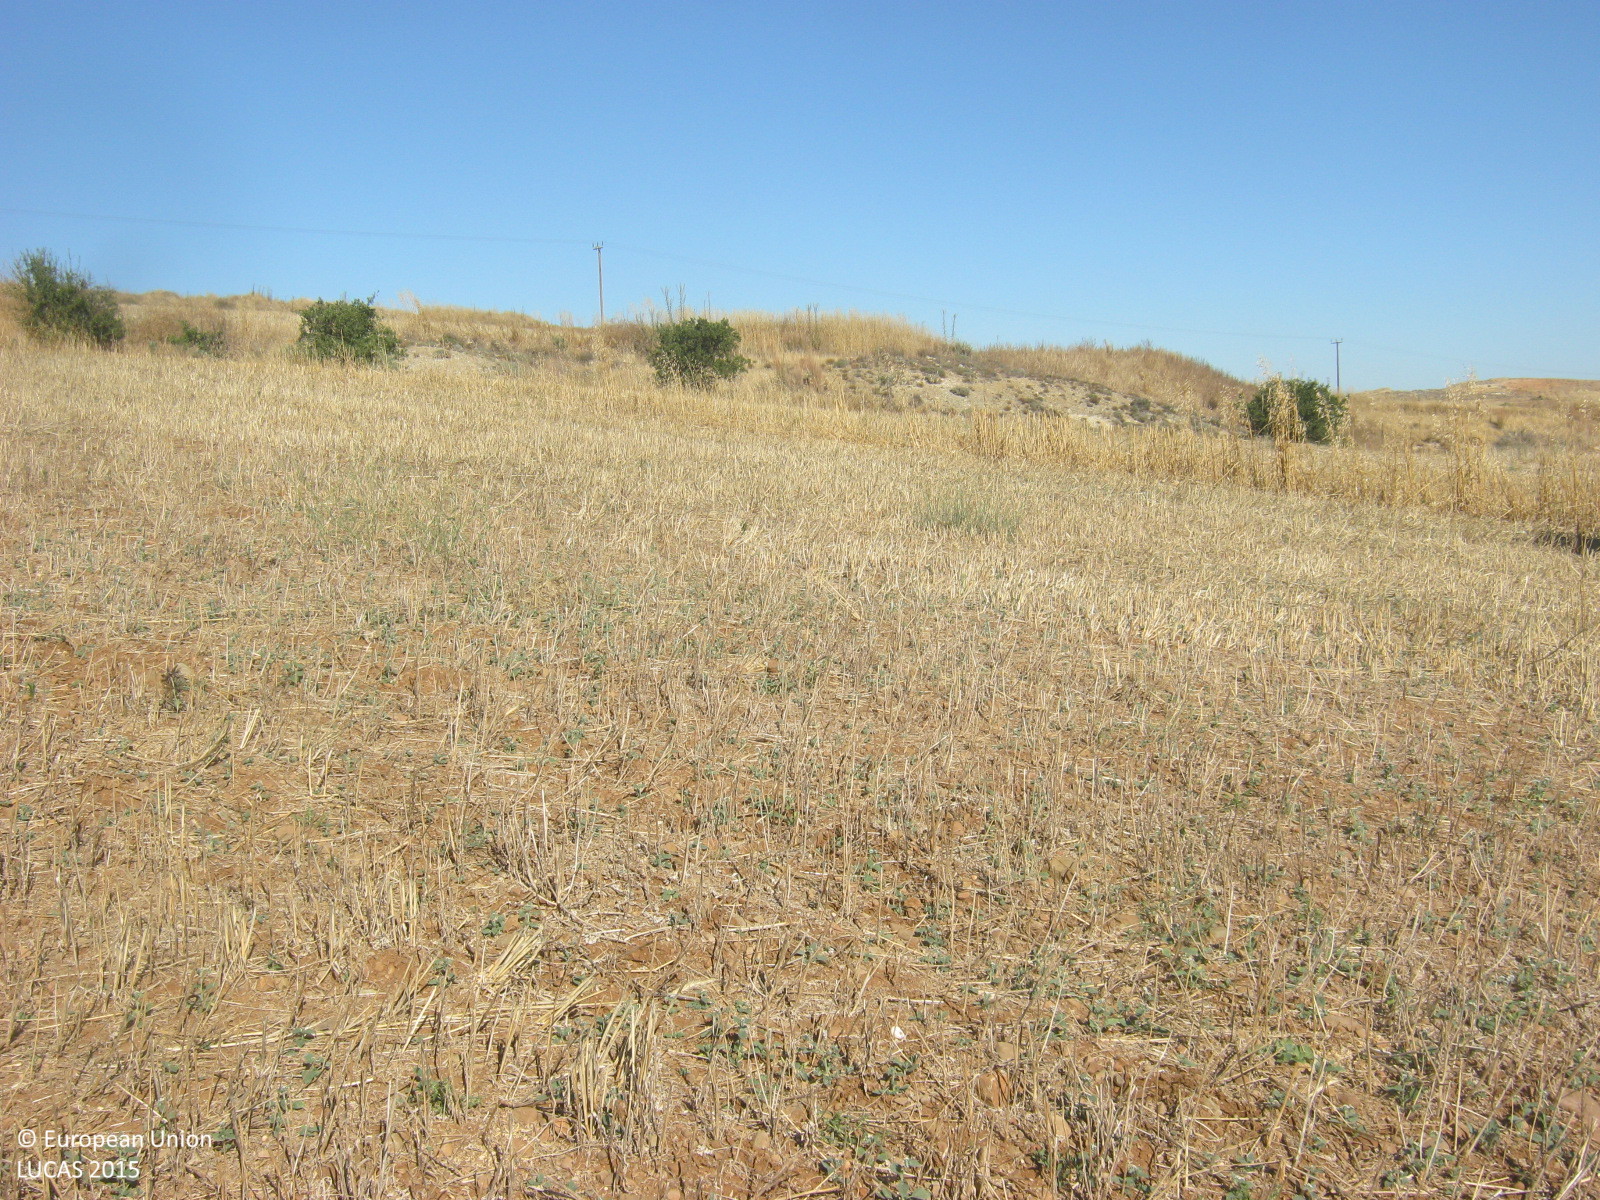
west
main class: Cropland
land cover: Barley
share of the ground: < 10 %
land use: Agriculture (excluding fallow land and kitchen gardens)
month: June
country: CY
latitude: 35.0844
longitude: 33.1839
